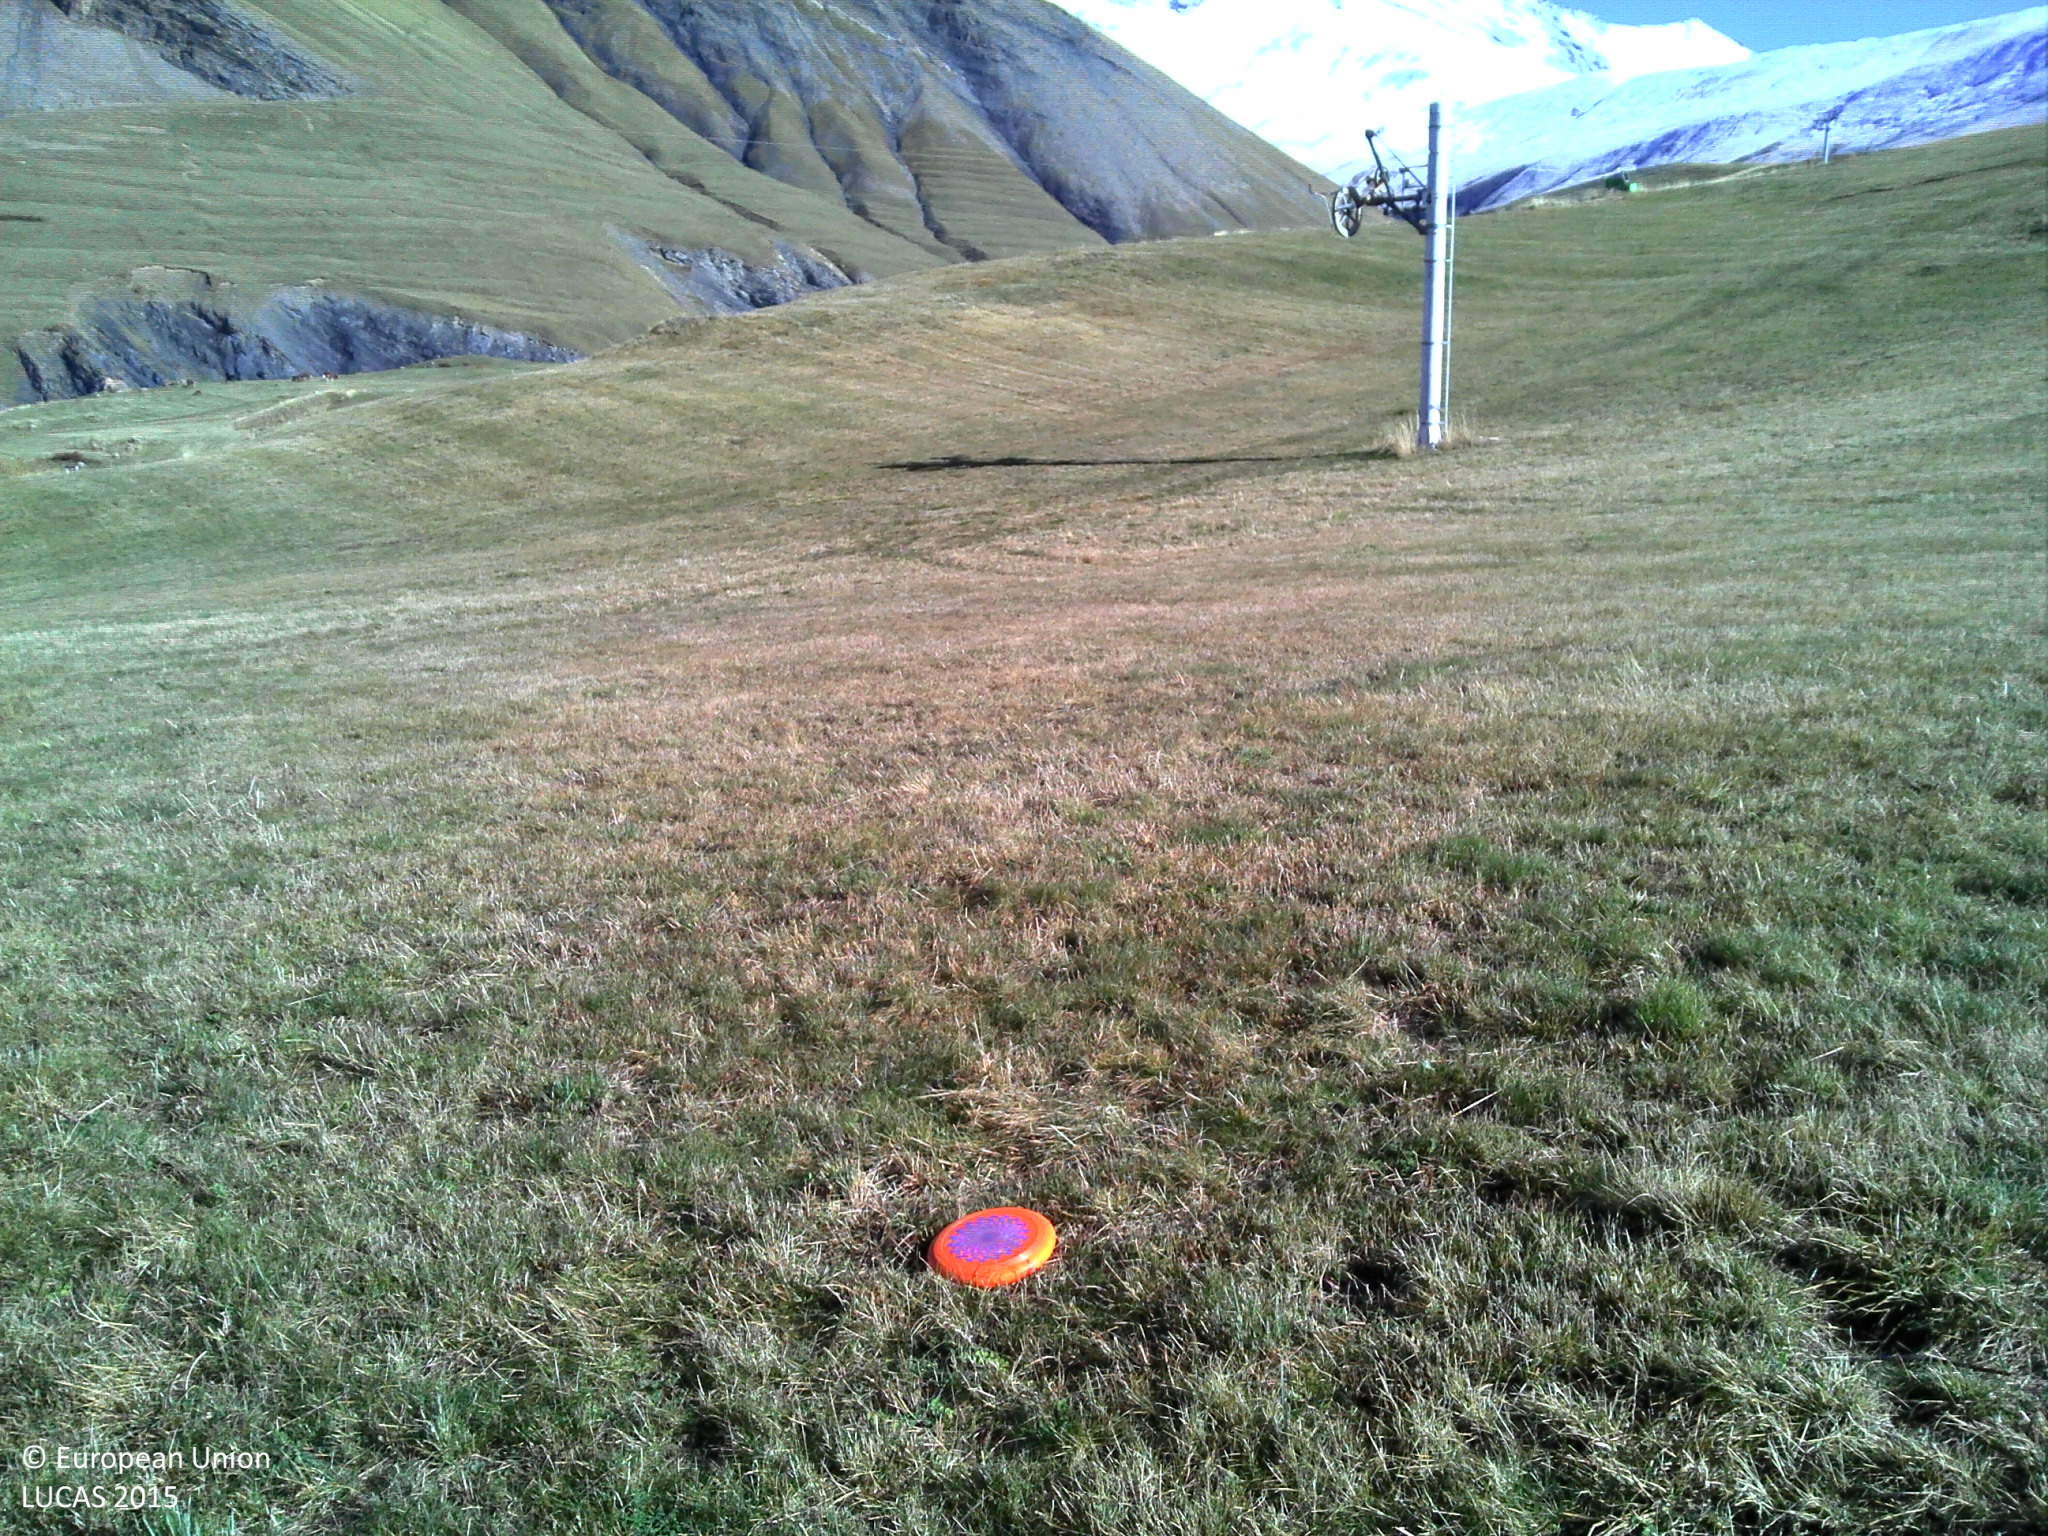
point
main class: Grassland
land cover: Grassland without tree/shrub cover
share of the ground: > 75 %
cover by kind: herbaceous plants 95 %, unconsolidated bare surface 5 %
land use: Agriculture (excluding fallow land and kitchen gardens)
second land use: Sport
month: October
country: FR
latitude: 45.0602
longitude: 6.2846
